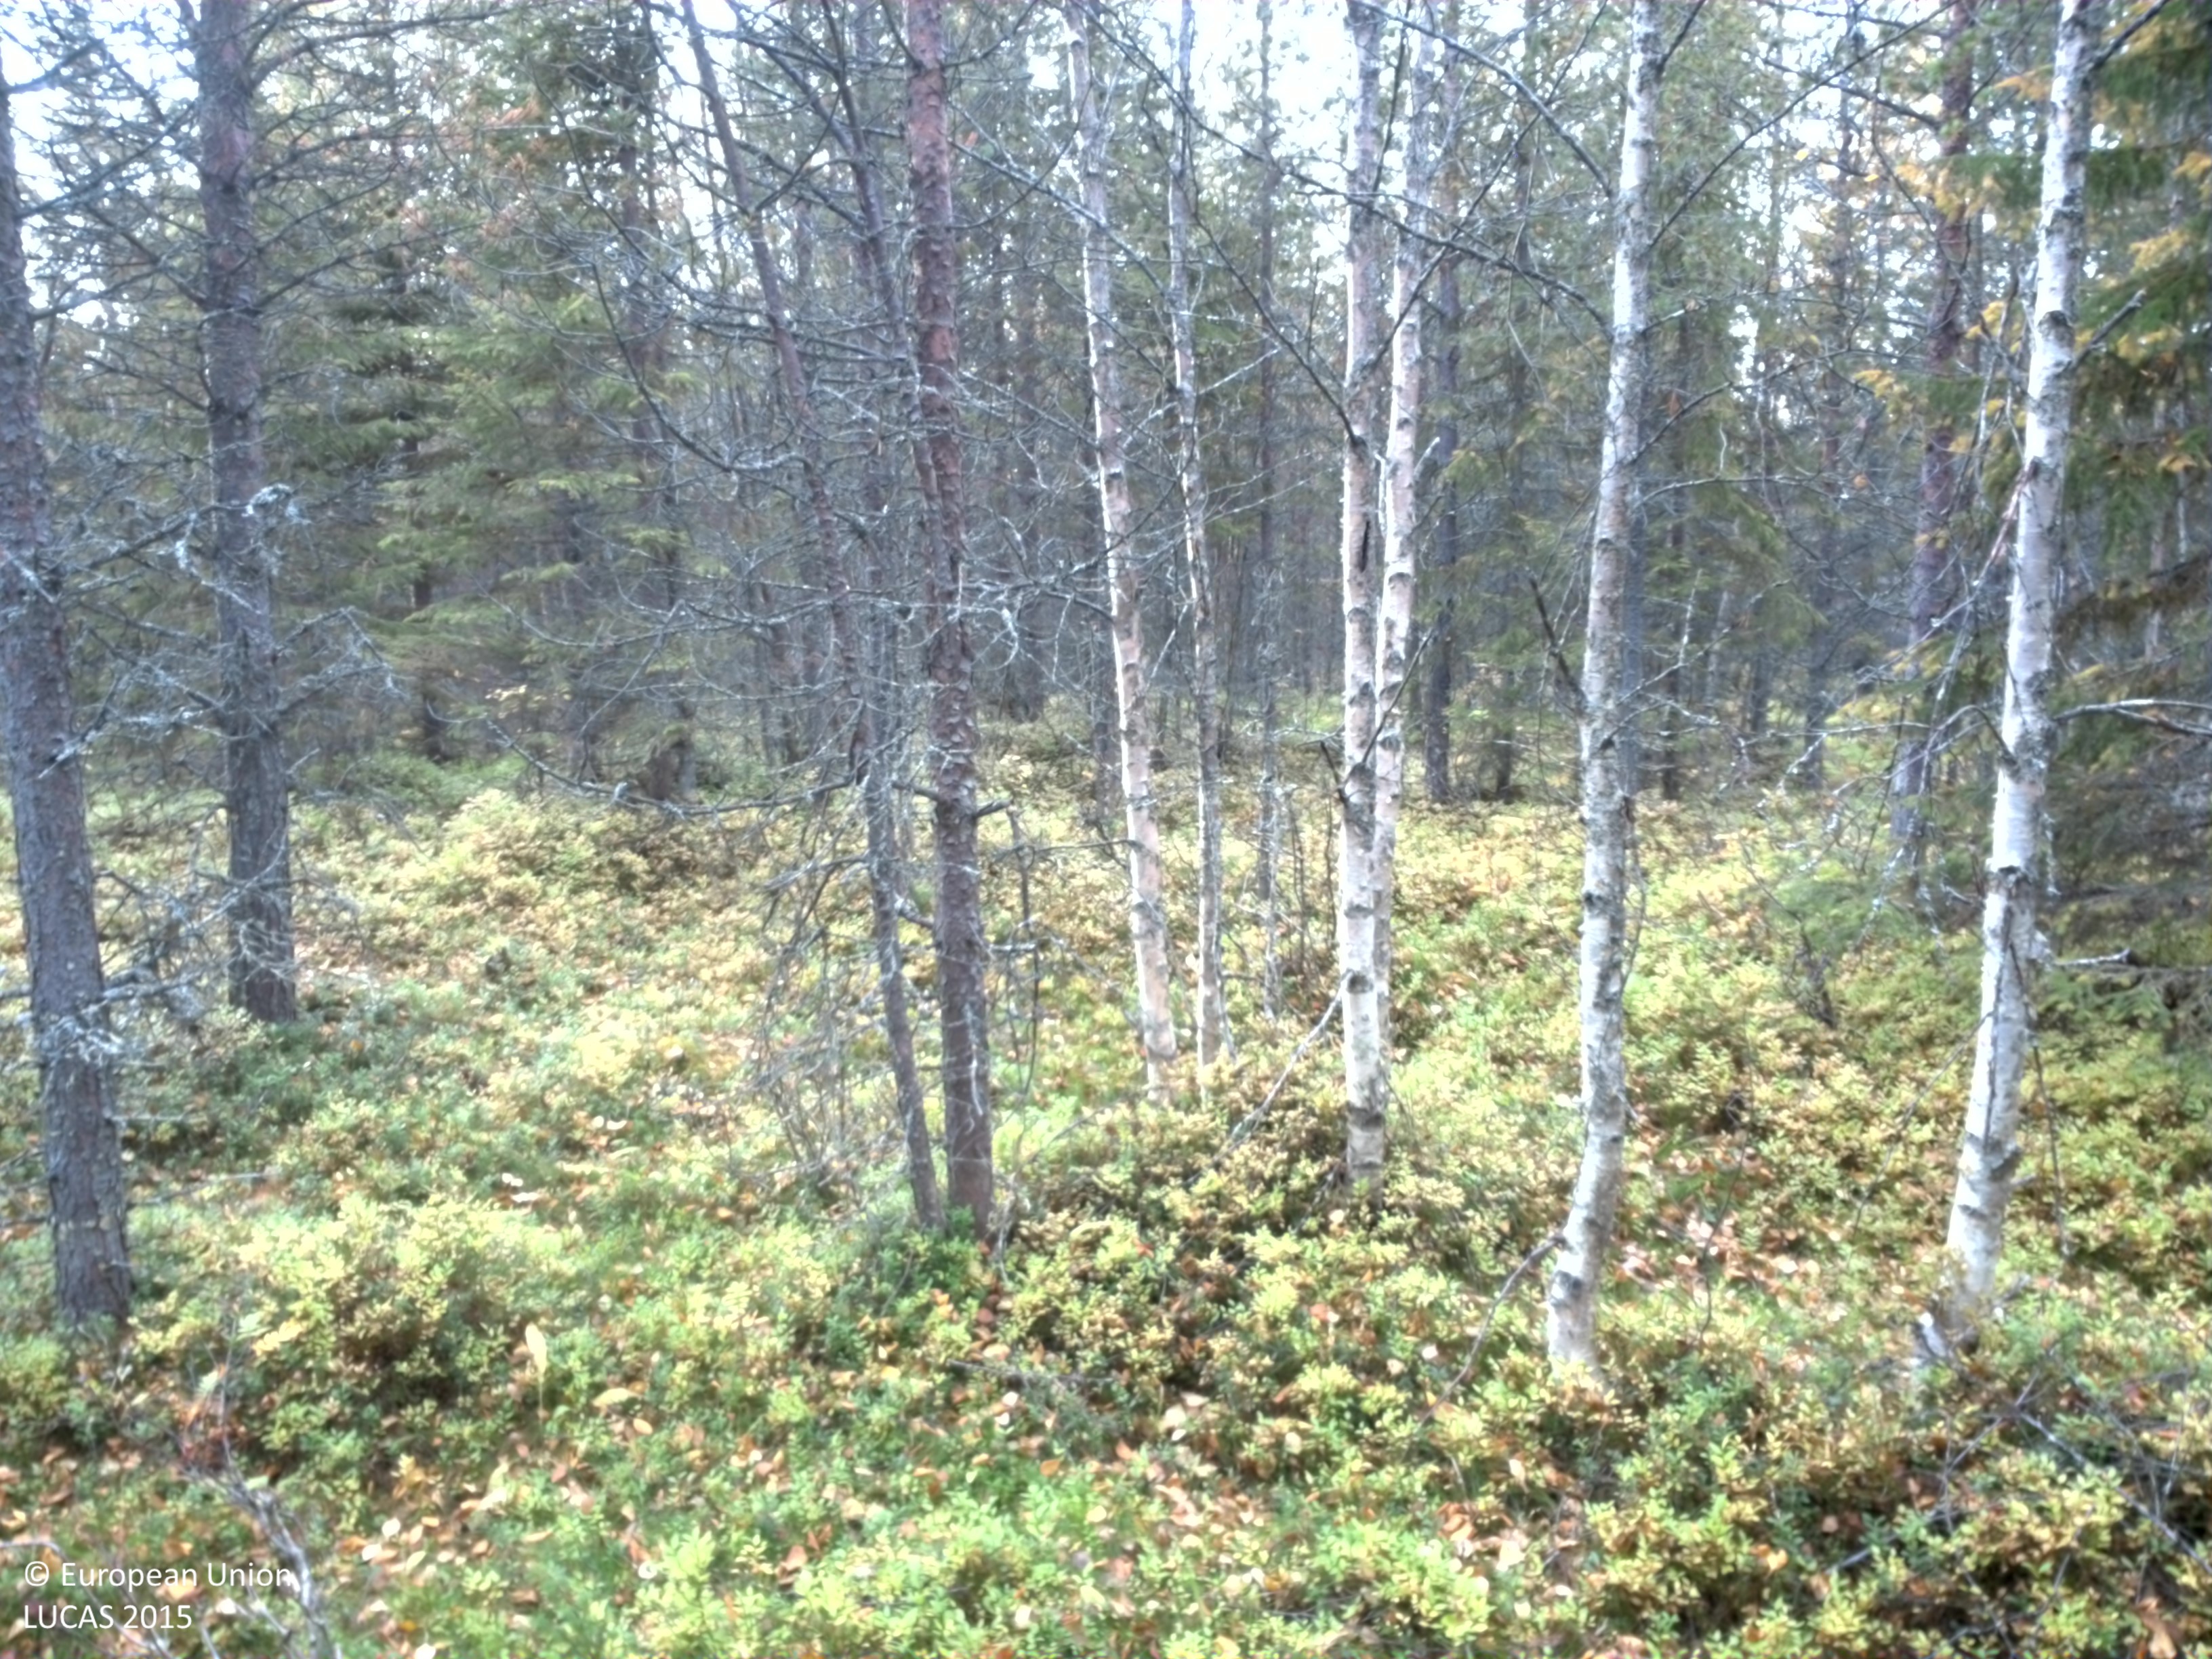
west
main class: Woodland
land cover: Pine dominated mixed woodland
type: boreal forest
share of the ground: 25 - 50 %
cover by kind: coniferous forest trees 30 %, shrubs 30 %, herbaceous plants 20 %, broadleaved forest trees 10 %, lichens and mosses 10 %
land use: Forestry
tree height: > 5 m
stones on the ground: < 10 %
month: October
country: SE
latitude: 64.9858
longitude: 17.4457
